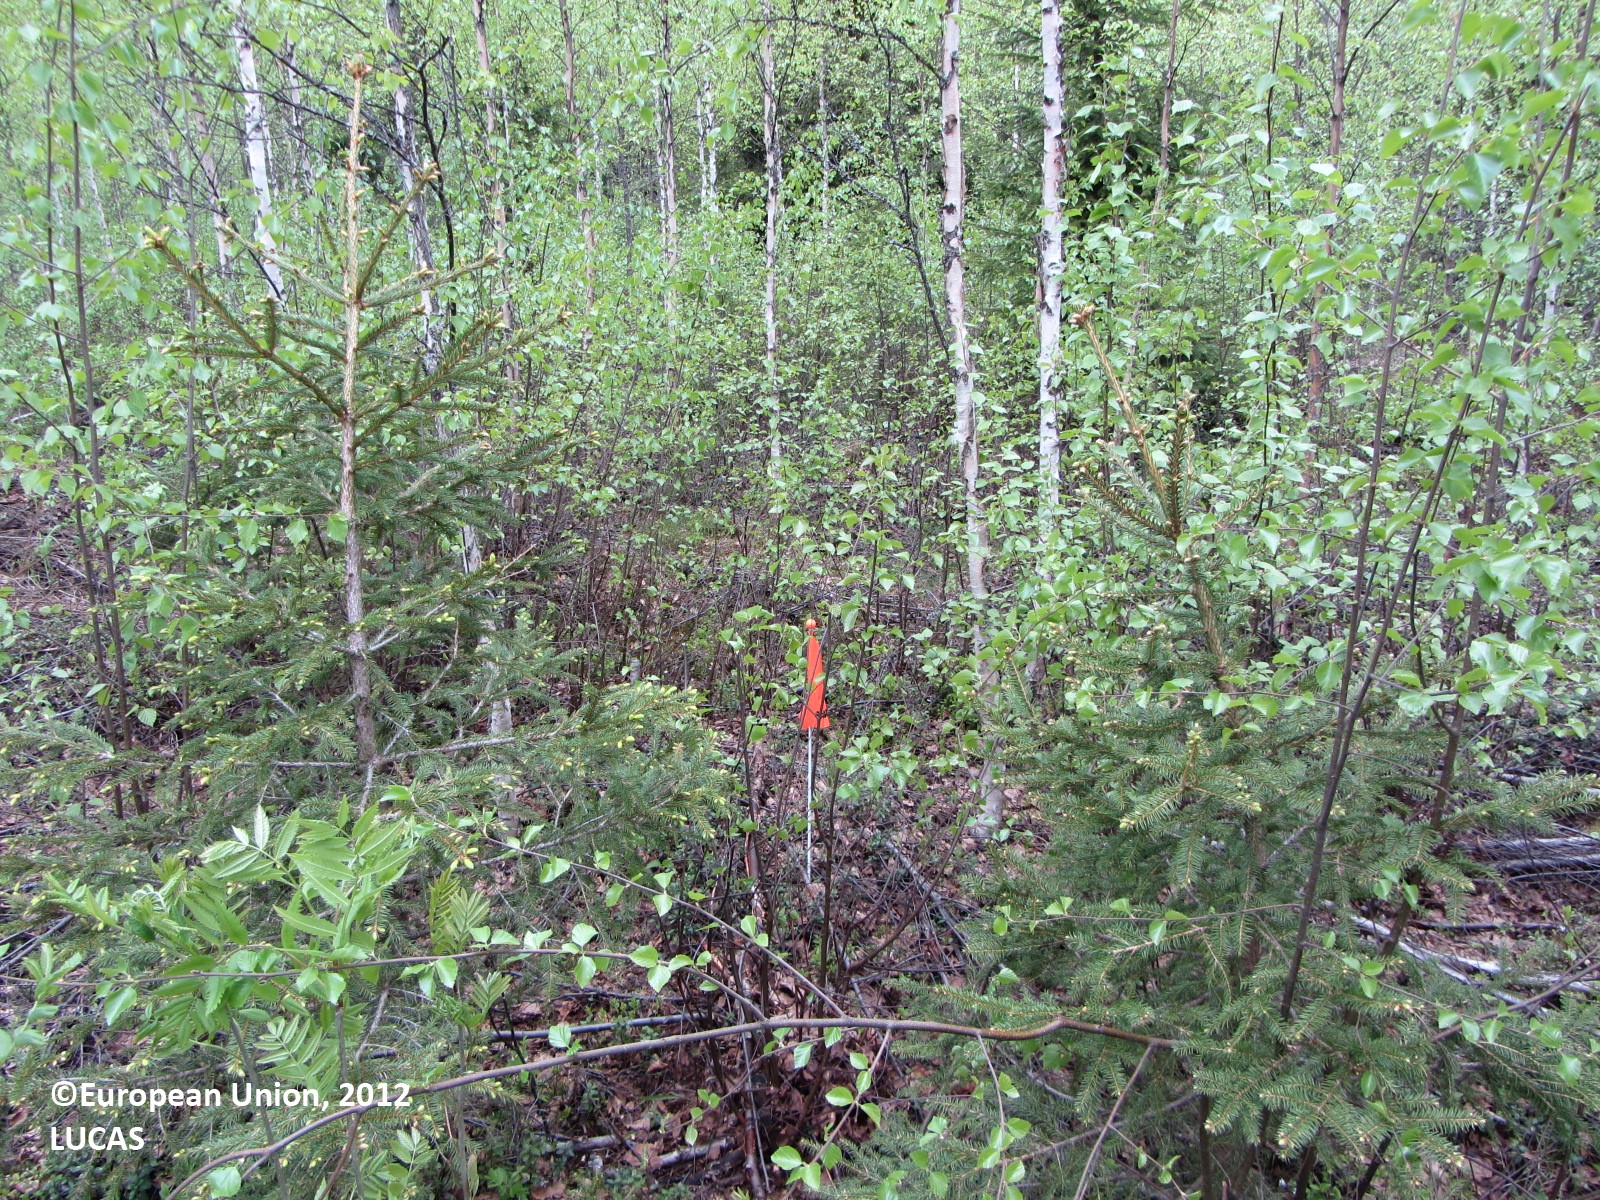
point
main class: Woodland
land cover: Broadleaved woodland
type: hemiboreal forest and nemoral coniferous forest and mixed broadleaved-coniferous forest
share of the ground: > 75 %
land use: Forestry
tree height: > 5 m
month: May
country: FI
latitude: 62.4092
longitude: 25.3403
